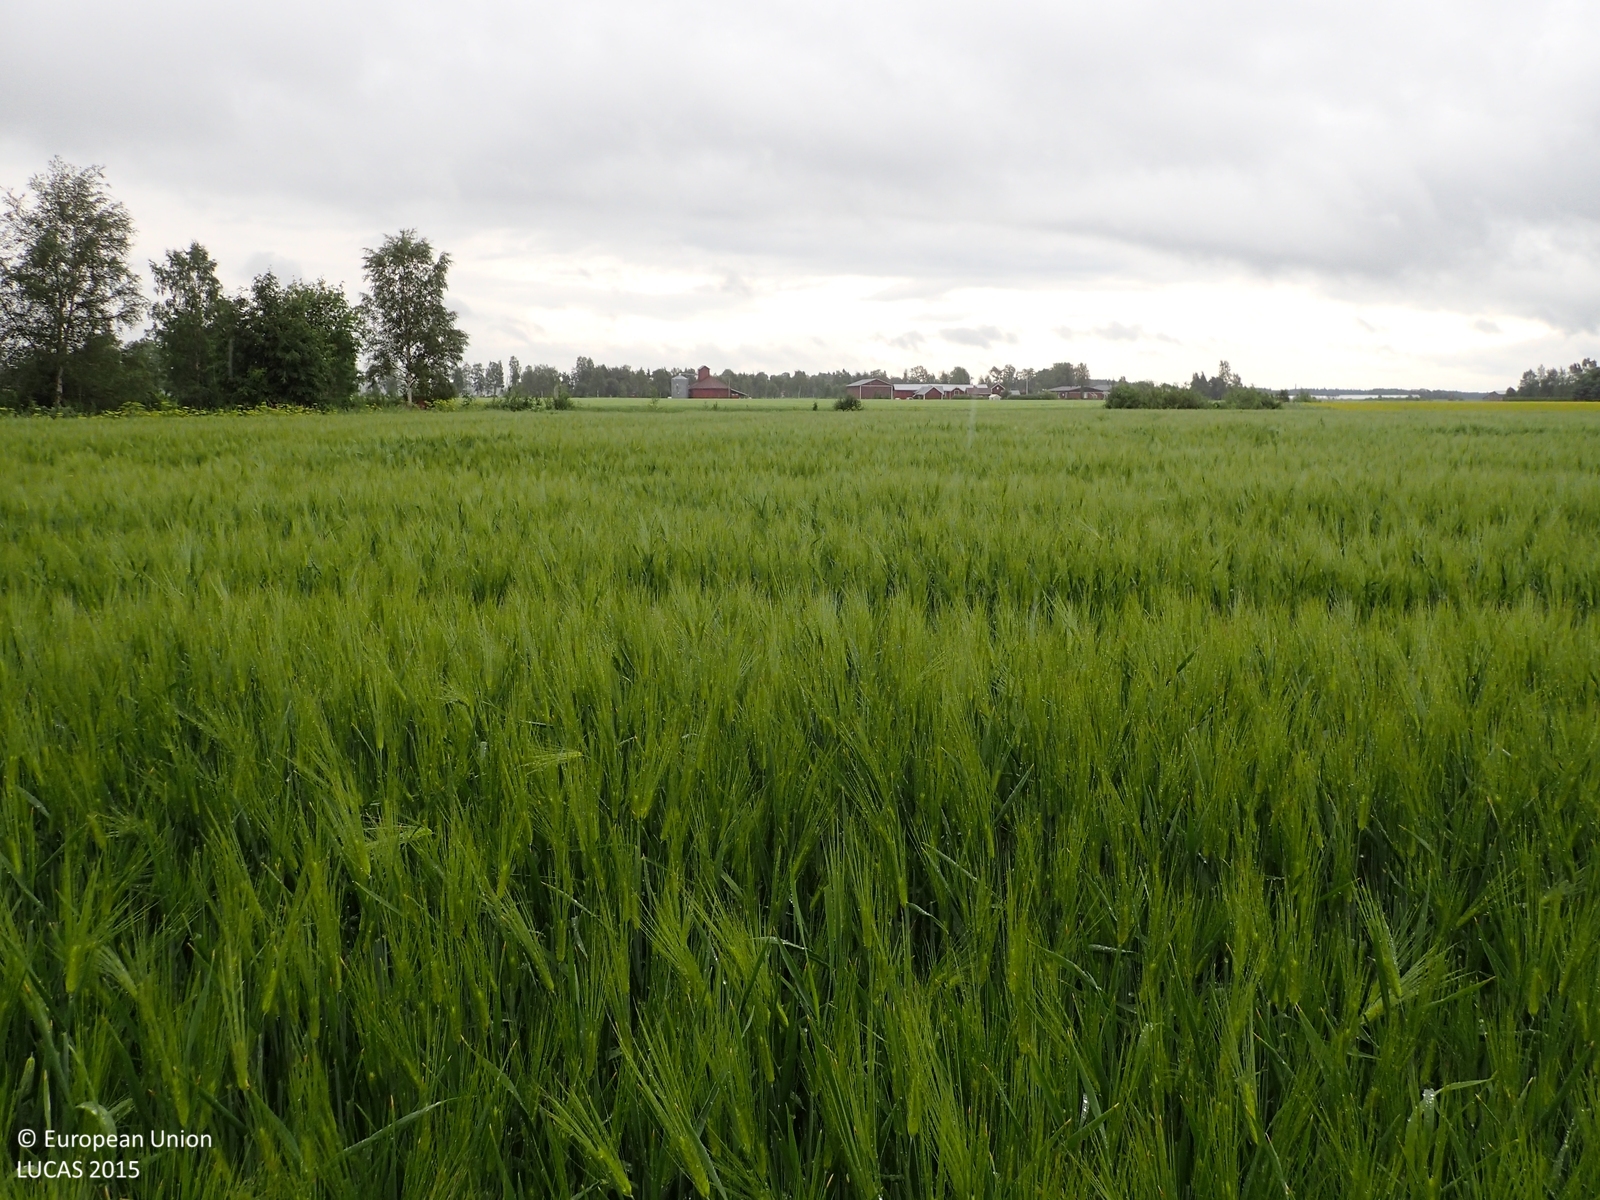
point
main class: Cropland
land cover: Barley
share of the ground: > 75 %
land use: Agriculture (excluding fallow land and kitchen gardens)
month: July
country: FI
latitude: 62.9970
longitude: 21.9088
